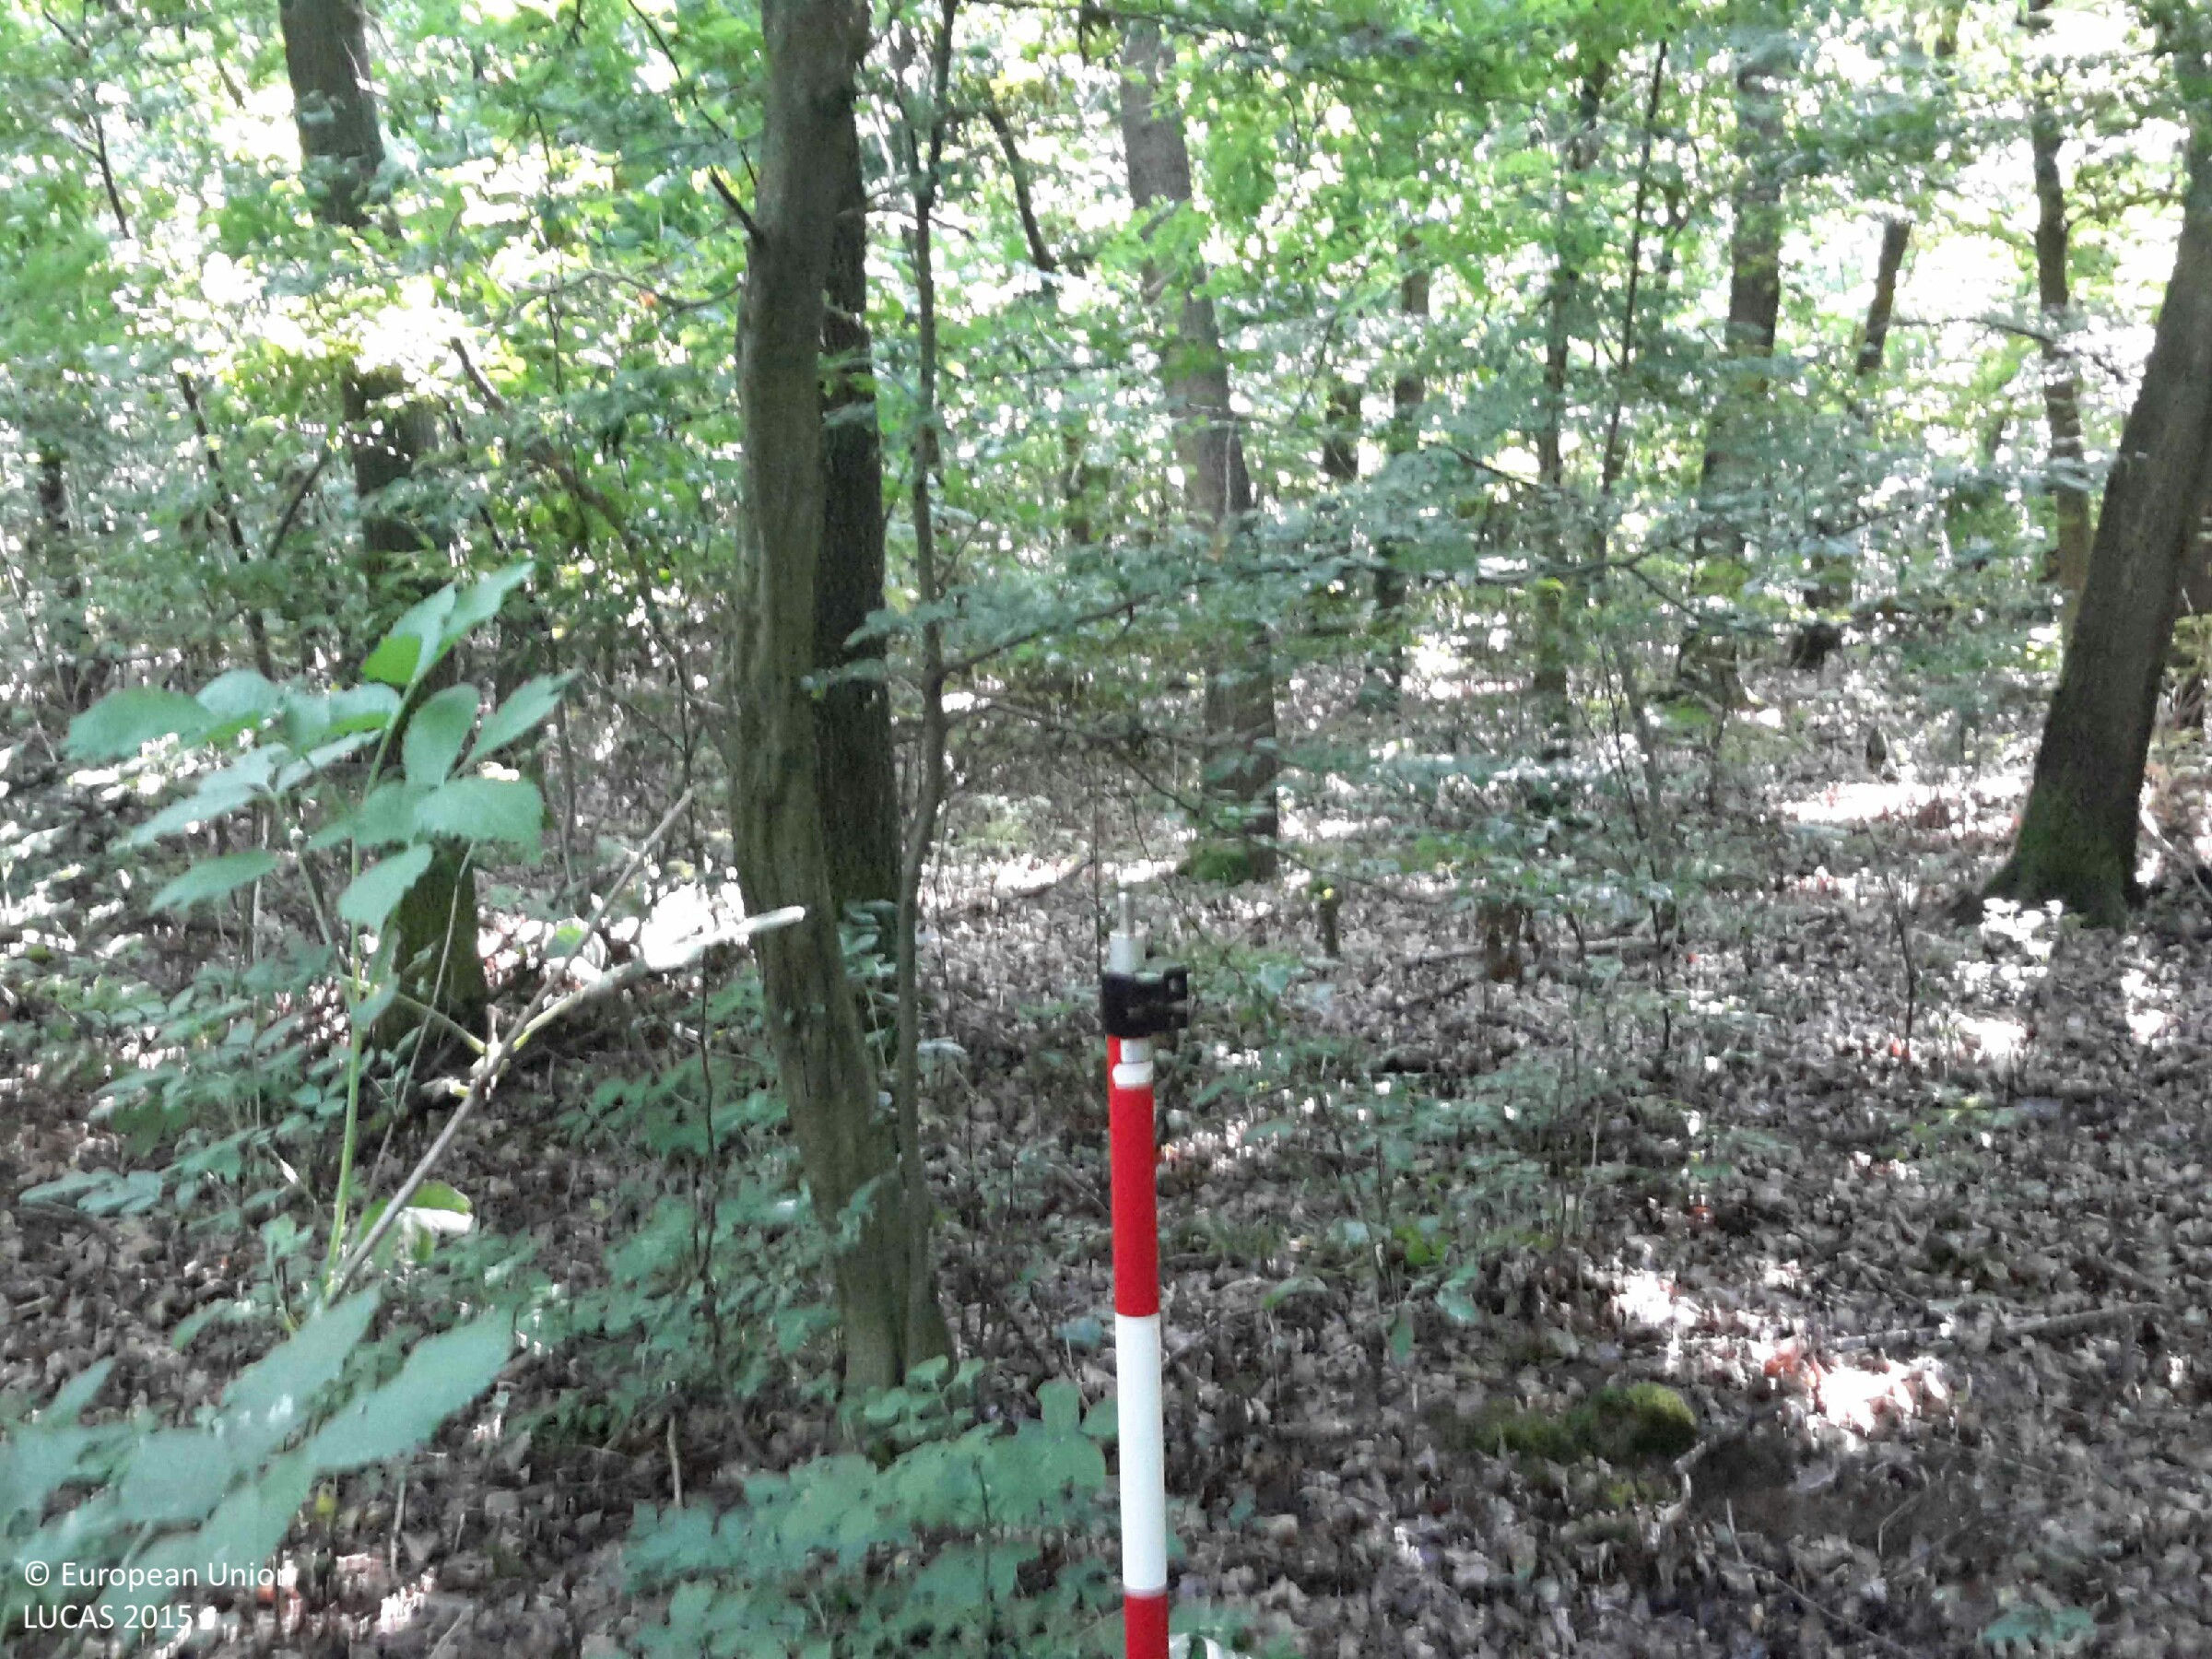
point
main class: Woodland
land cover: Broadleaved woodland
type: mesophytic deciduous forest
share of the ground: > 75 %
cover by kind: broadleaved forest trees 90 %, shrubs 10 %
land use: Forestry
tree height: > 5 m
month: July
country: HU
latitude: 47.0856
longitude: 17.1842
